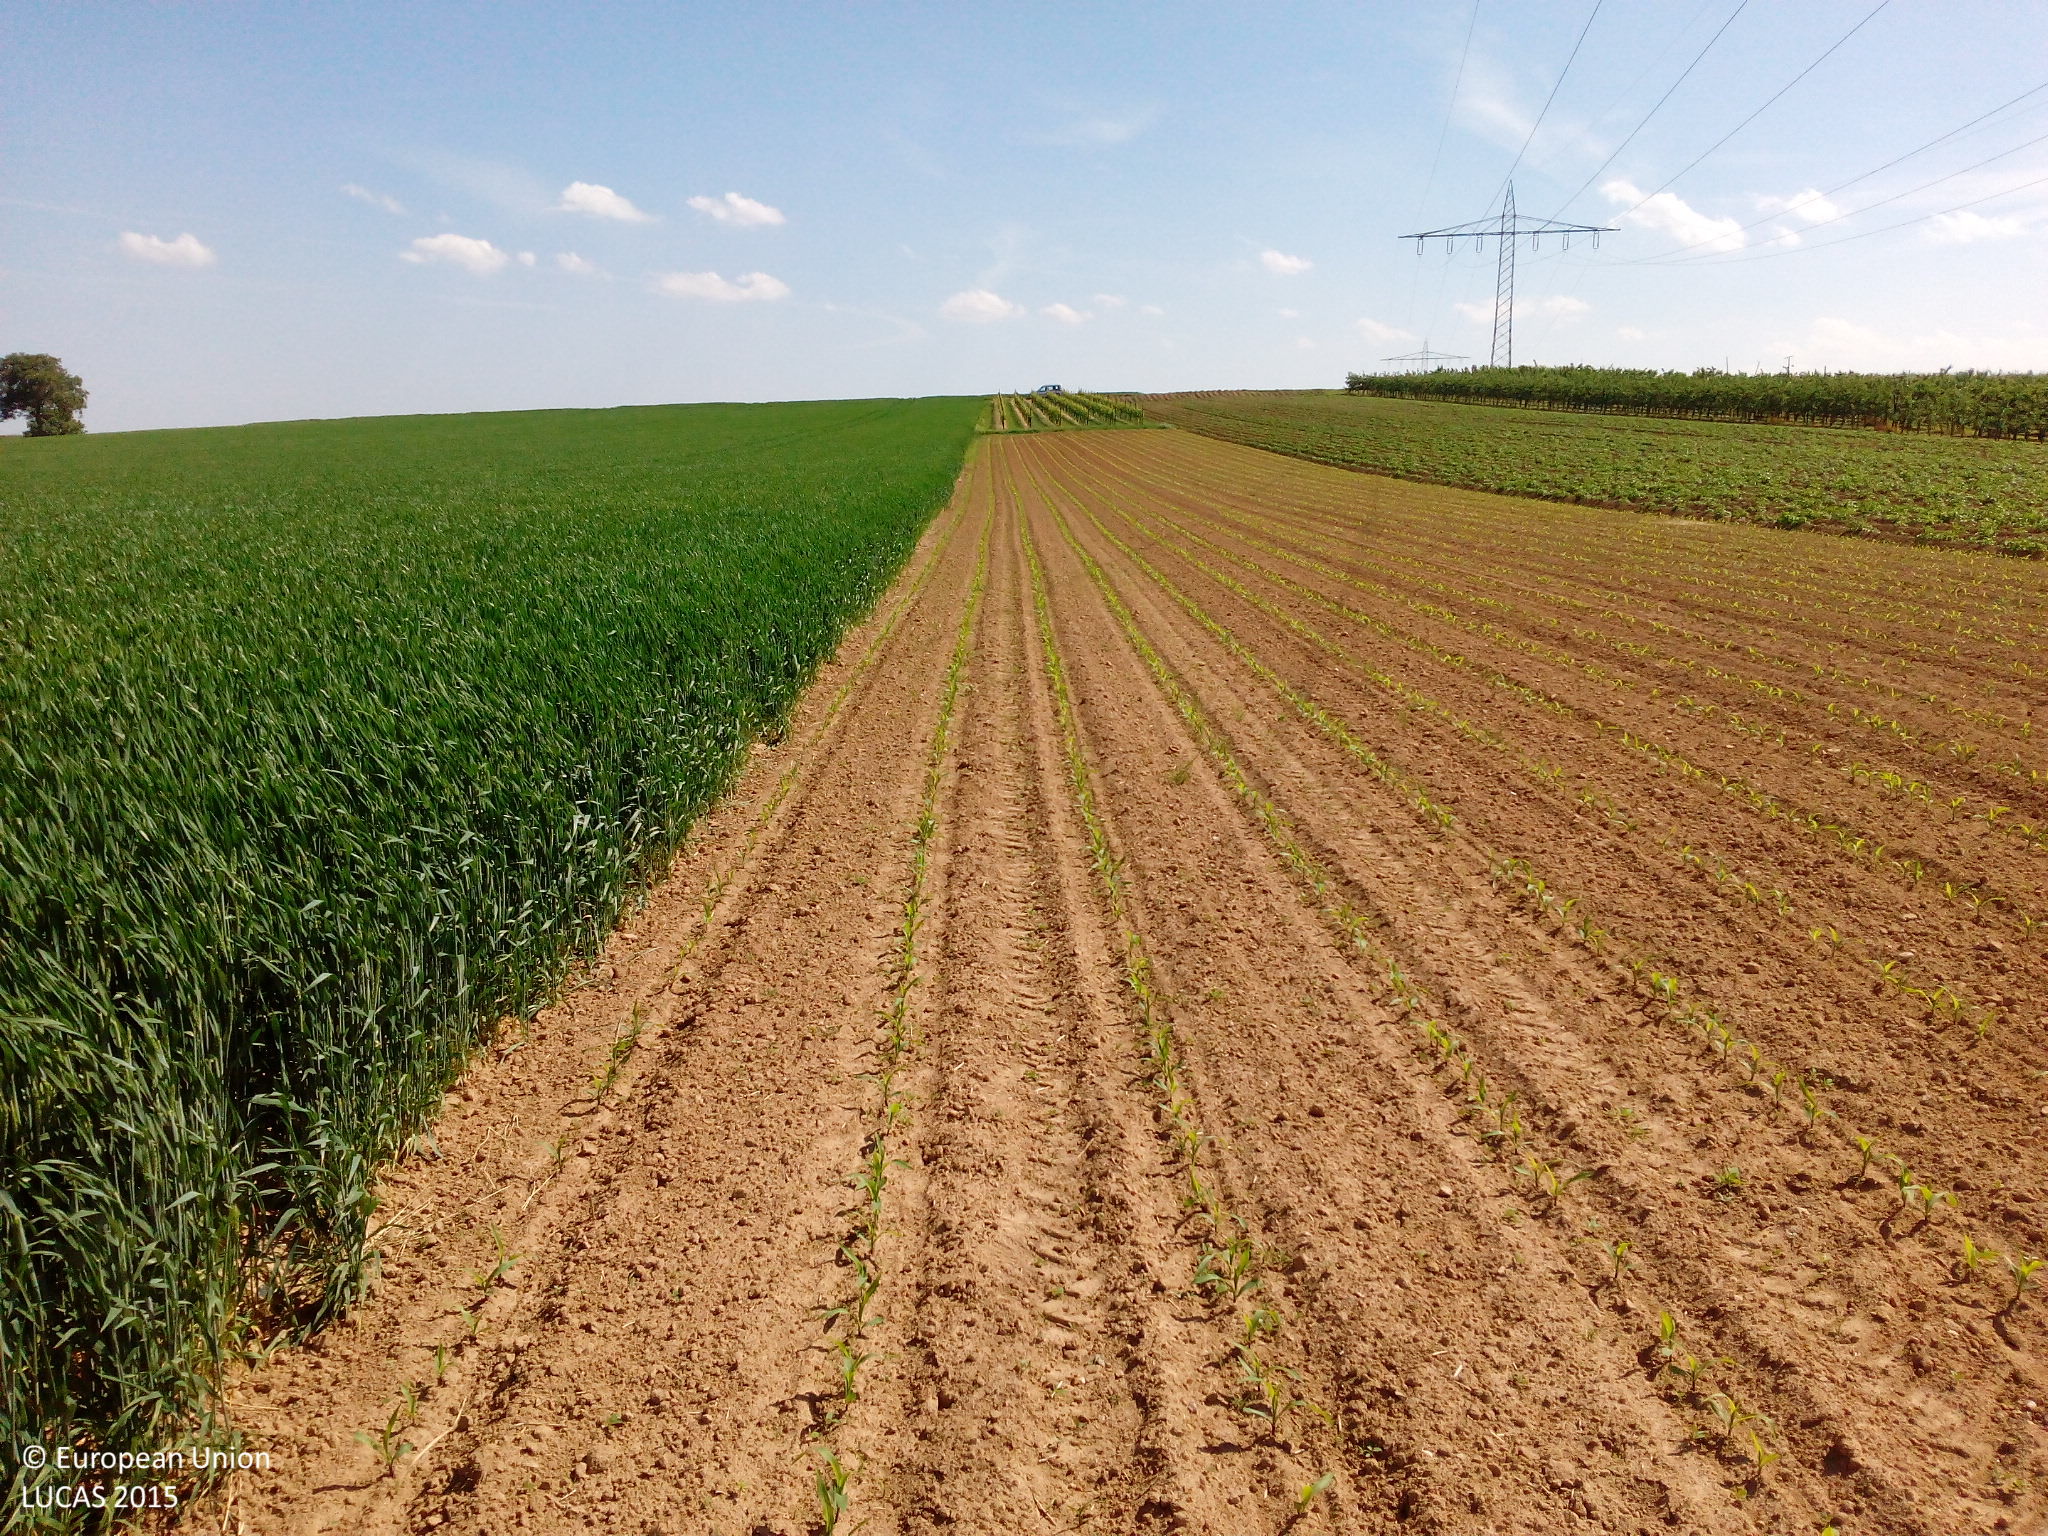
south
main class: Cropland
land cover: Common wheat
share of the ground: > 75 %
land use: Agriculture (excluding fallow land and kitchen gardens)
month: May
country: DE
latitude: 49.1802
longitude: 8.1760
